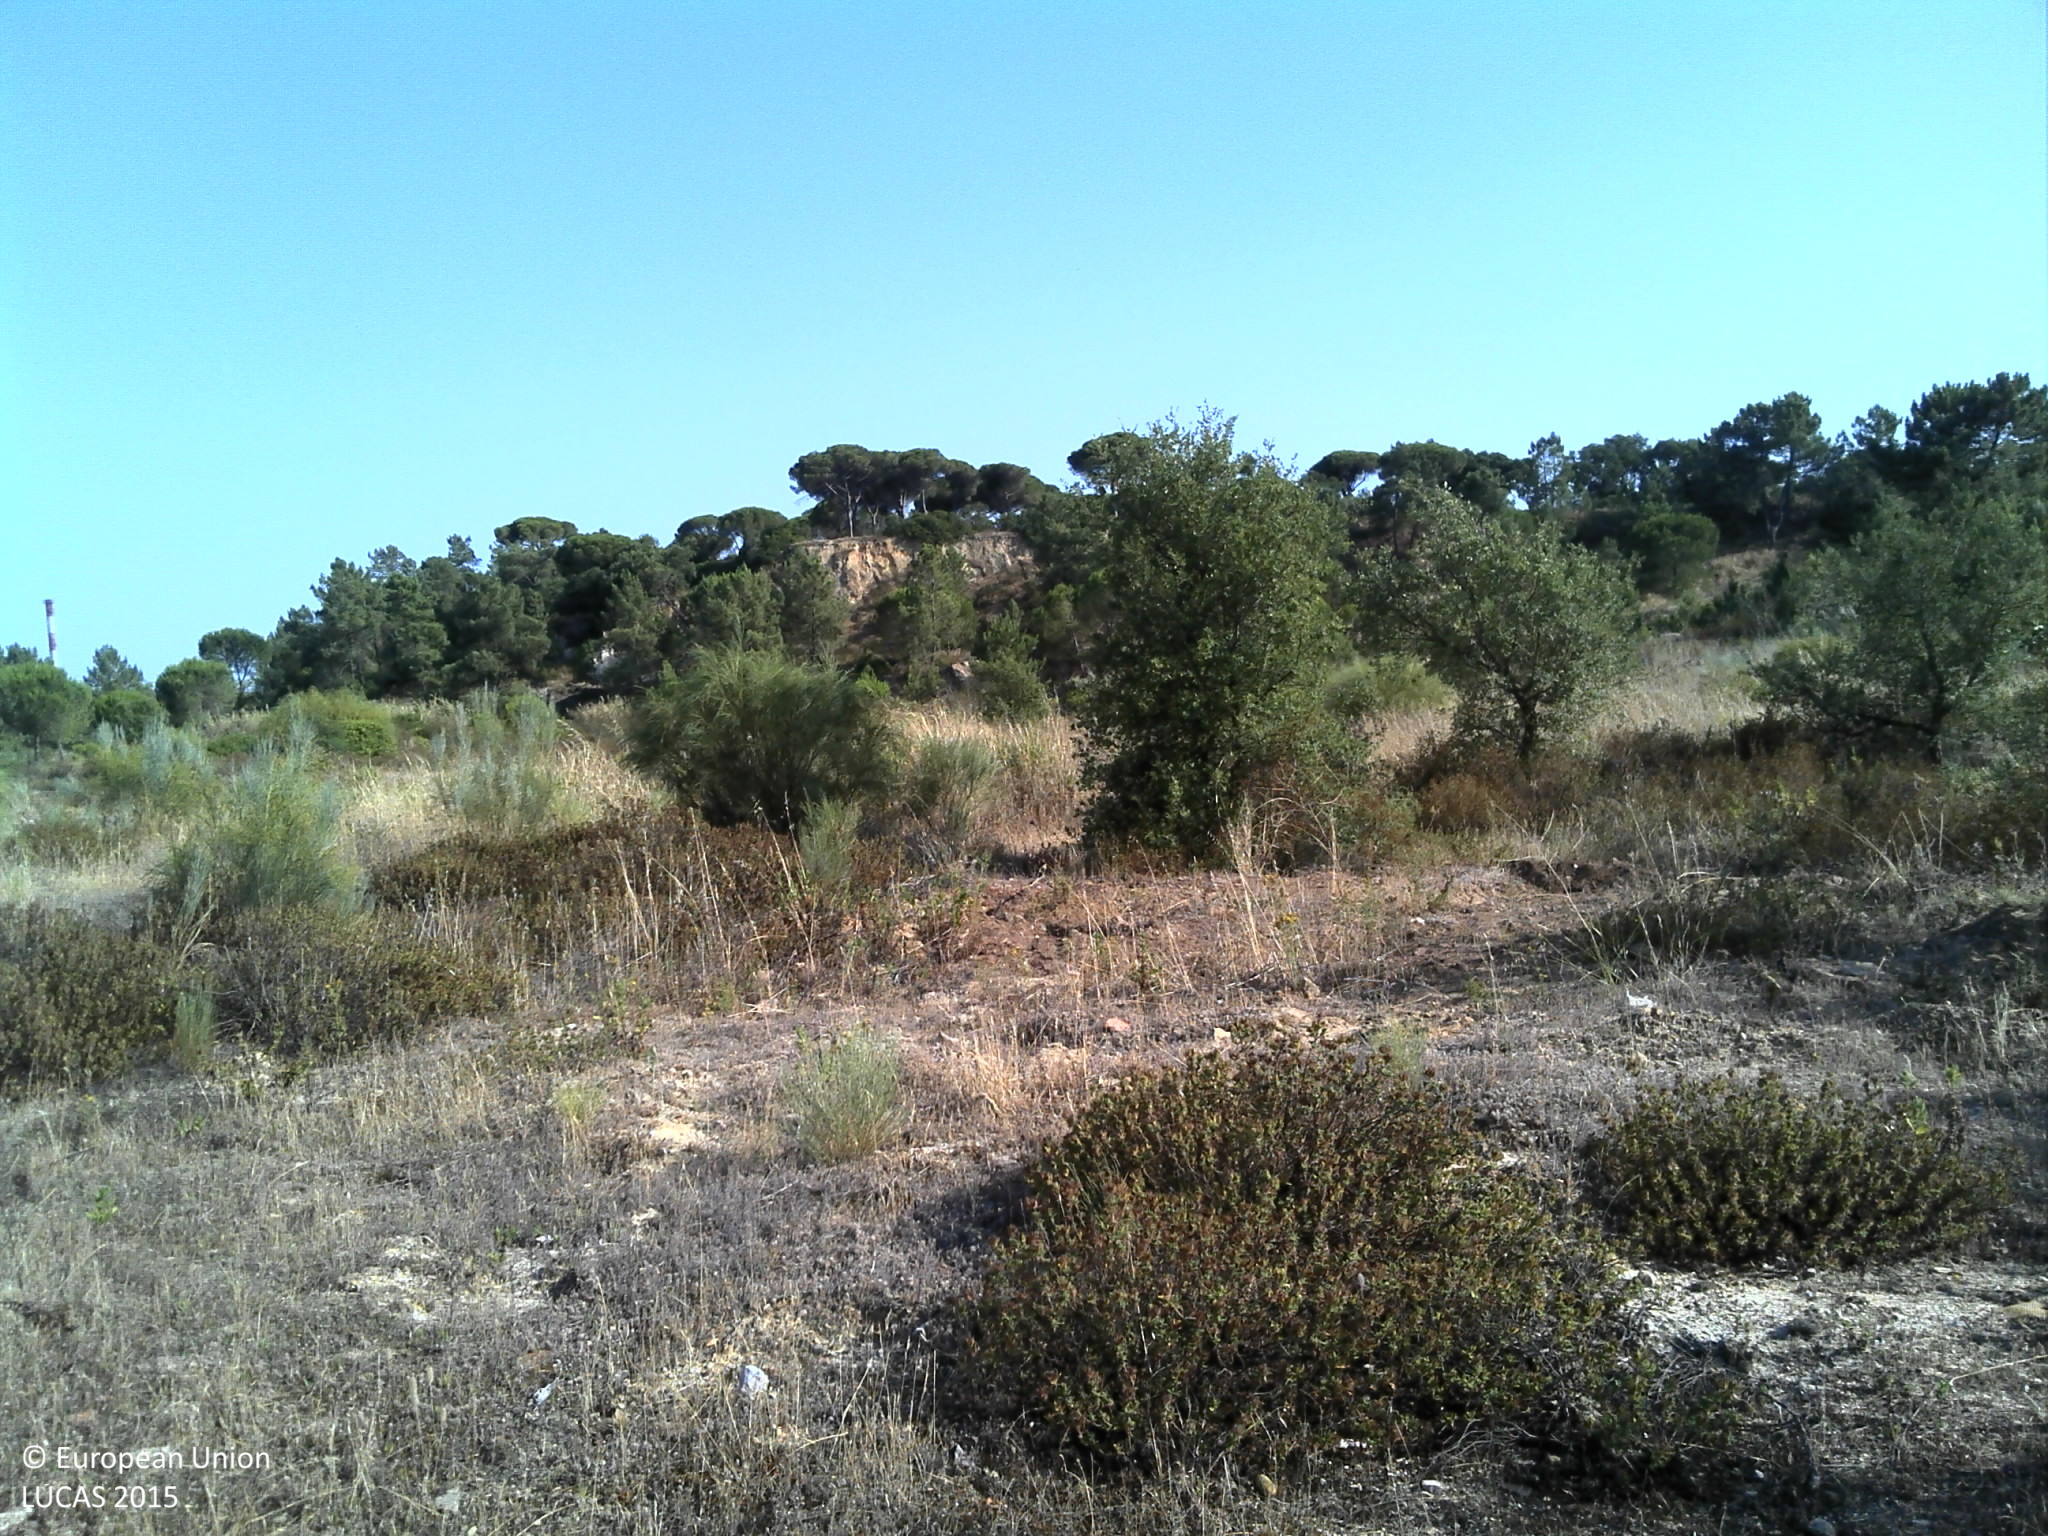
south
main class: Grassland
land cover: Grassland with sparse tree/shrub cover
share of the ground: 25 - 50 %
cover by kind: unconsolidated bare surface 60 %, herbaceous plants 30 %, broadleaved forest trees 5 %, shrubs 5 %
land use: Abandoned areas
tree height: < 5 m
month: June
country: PT
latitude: 38.6337
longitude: -9.0839
